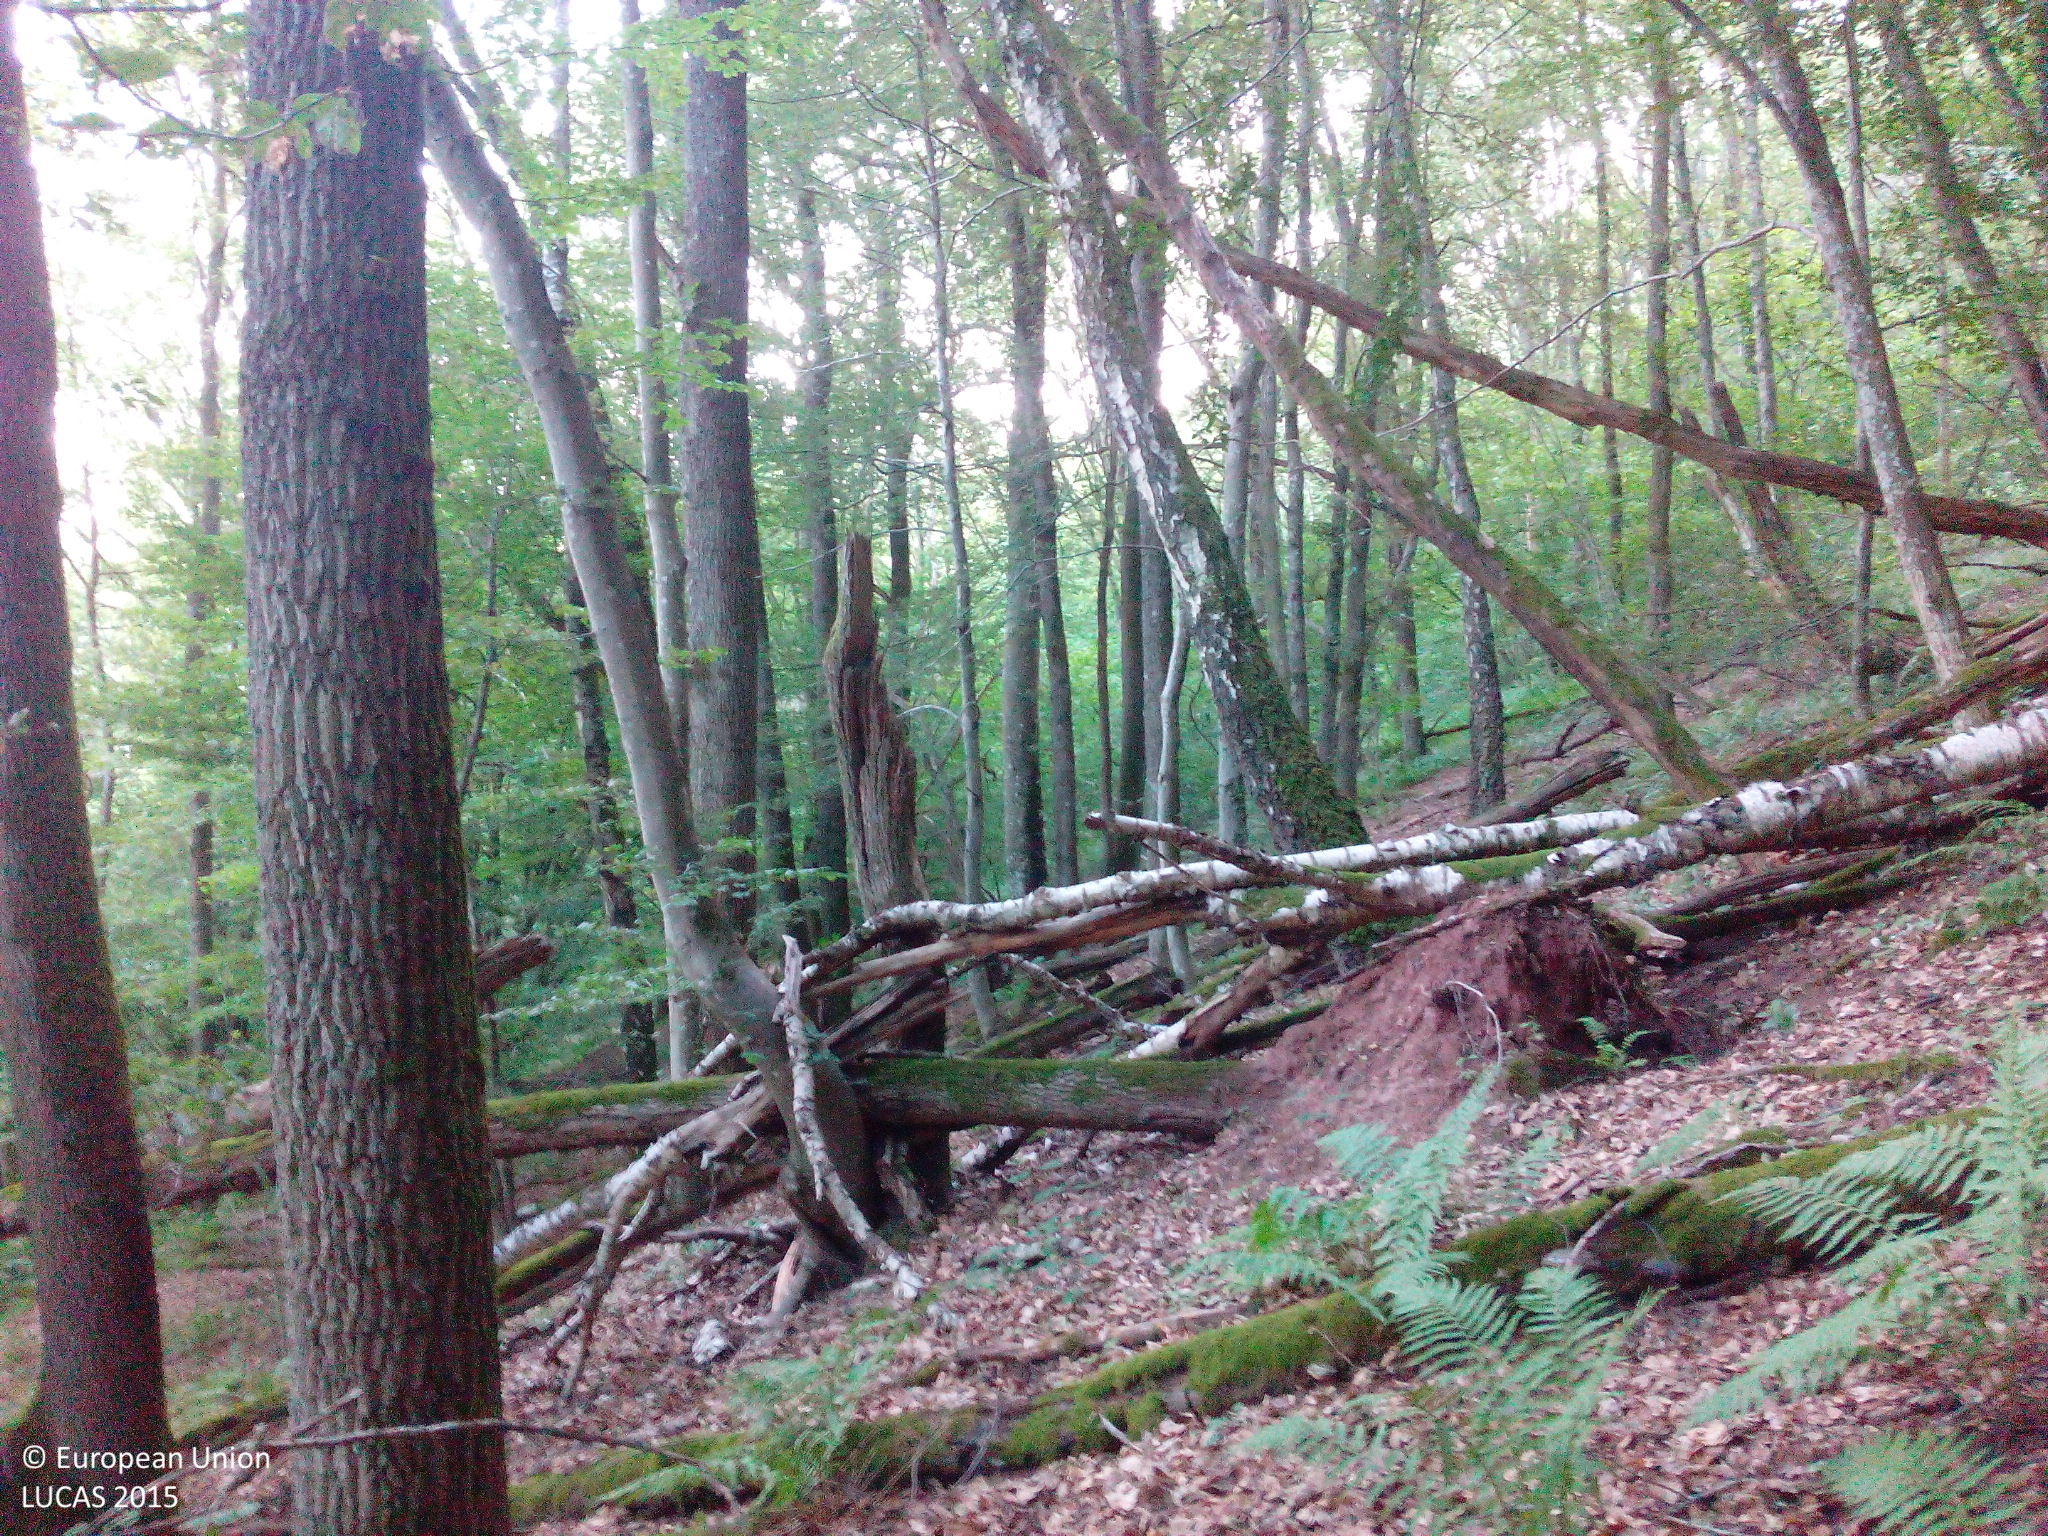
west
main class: Woodland
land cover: Broadleaved woodland
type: beech forest
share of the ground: > 75 %
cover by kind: broadleaved forest trees 90 %, unconsolidated bare surface 10 %
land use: Abandoned areas
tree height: > 5 m
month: July
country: DE
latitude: 49.1329
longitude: 7.5747
